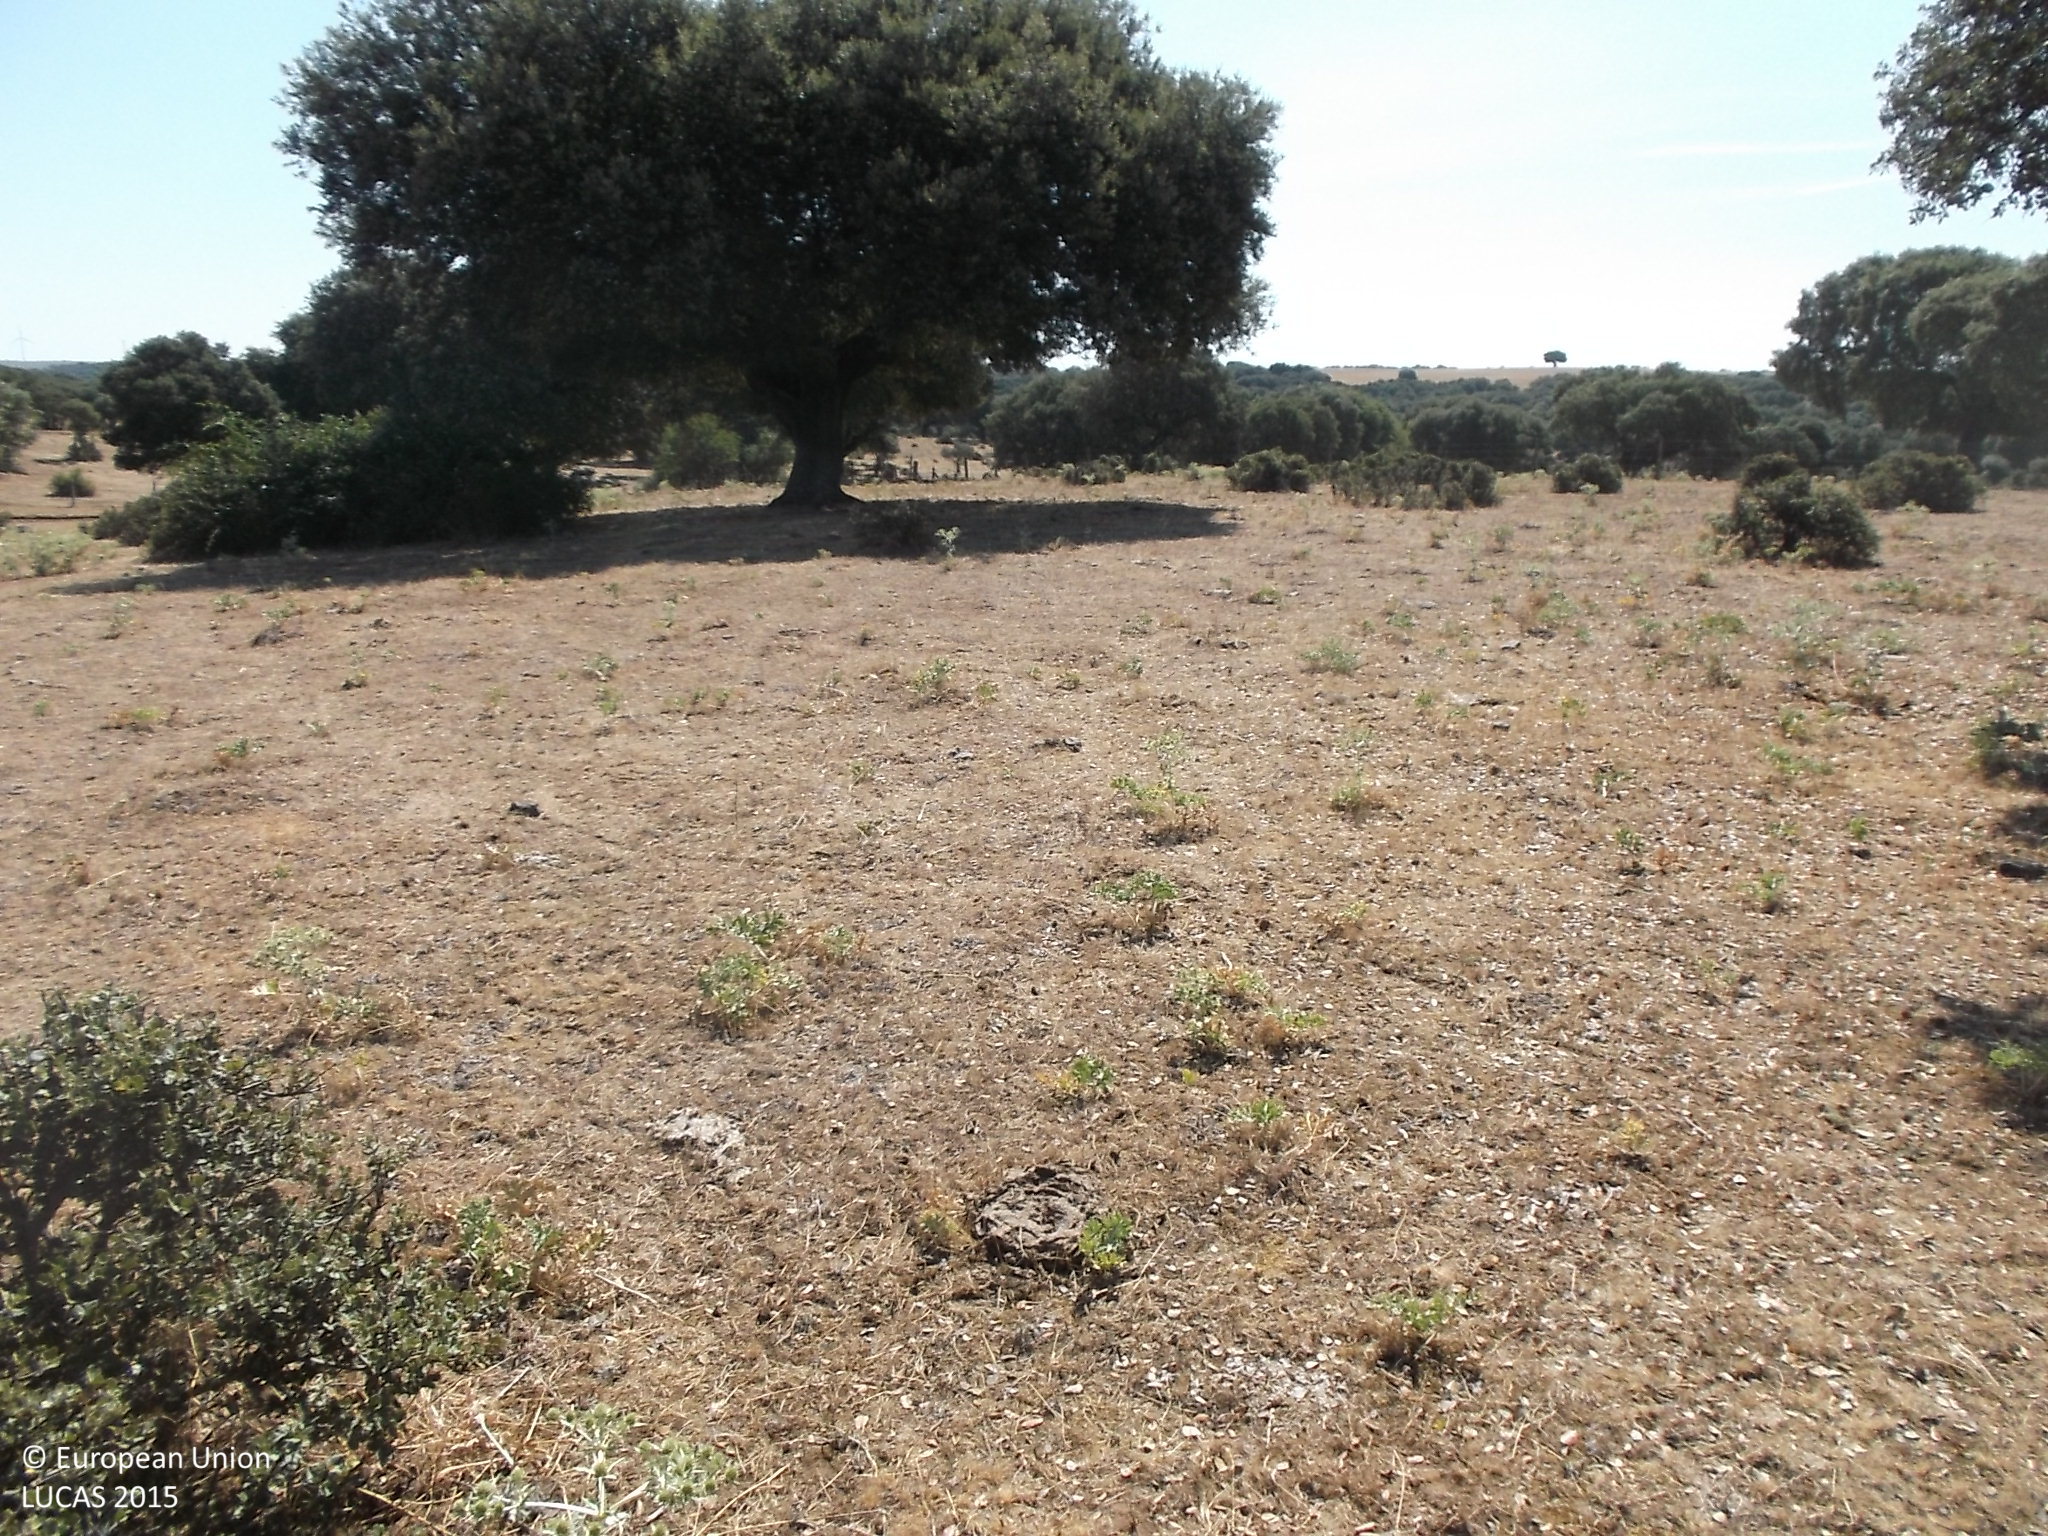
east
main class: Woodland
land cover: Broadleaved woodland
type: broadleaved evergreen forest
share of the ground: 25 - 50 %
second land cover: Shrubland without tree cover
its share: 50 - 75 %
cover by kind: herbaceous plants 40 %, broadleaved forest trees 30 %, shrubs 30 %
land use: Forestry
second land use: Agriculture (excluding fallow land and kitchen gardens)
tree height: < 5 m
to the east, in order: Broadleaved woodland; Shrubland without tree cover; Grassland without tree/shrub cover; Fences; Grassland without tree/shrub cover; Fences; Grassland with sparse tree/shrub cover
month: July
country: ES
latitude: 41.1957
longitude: -5.9571
